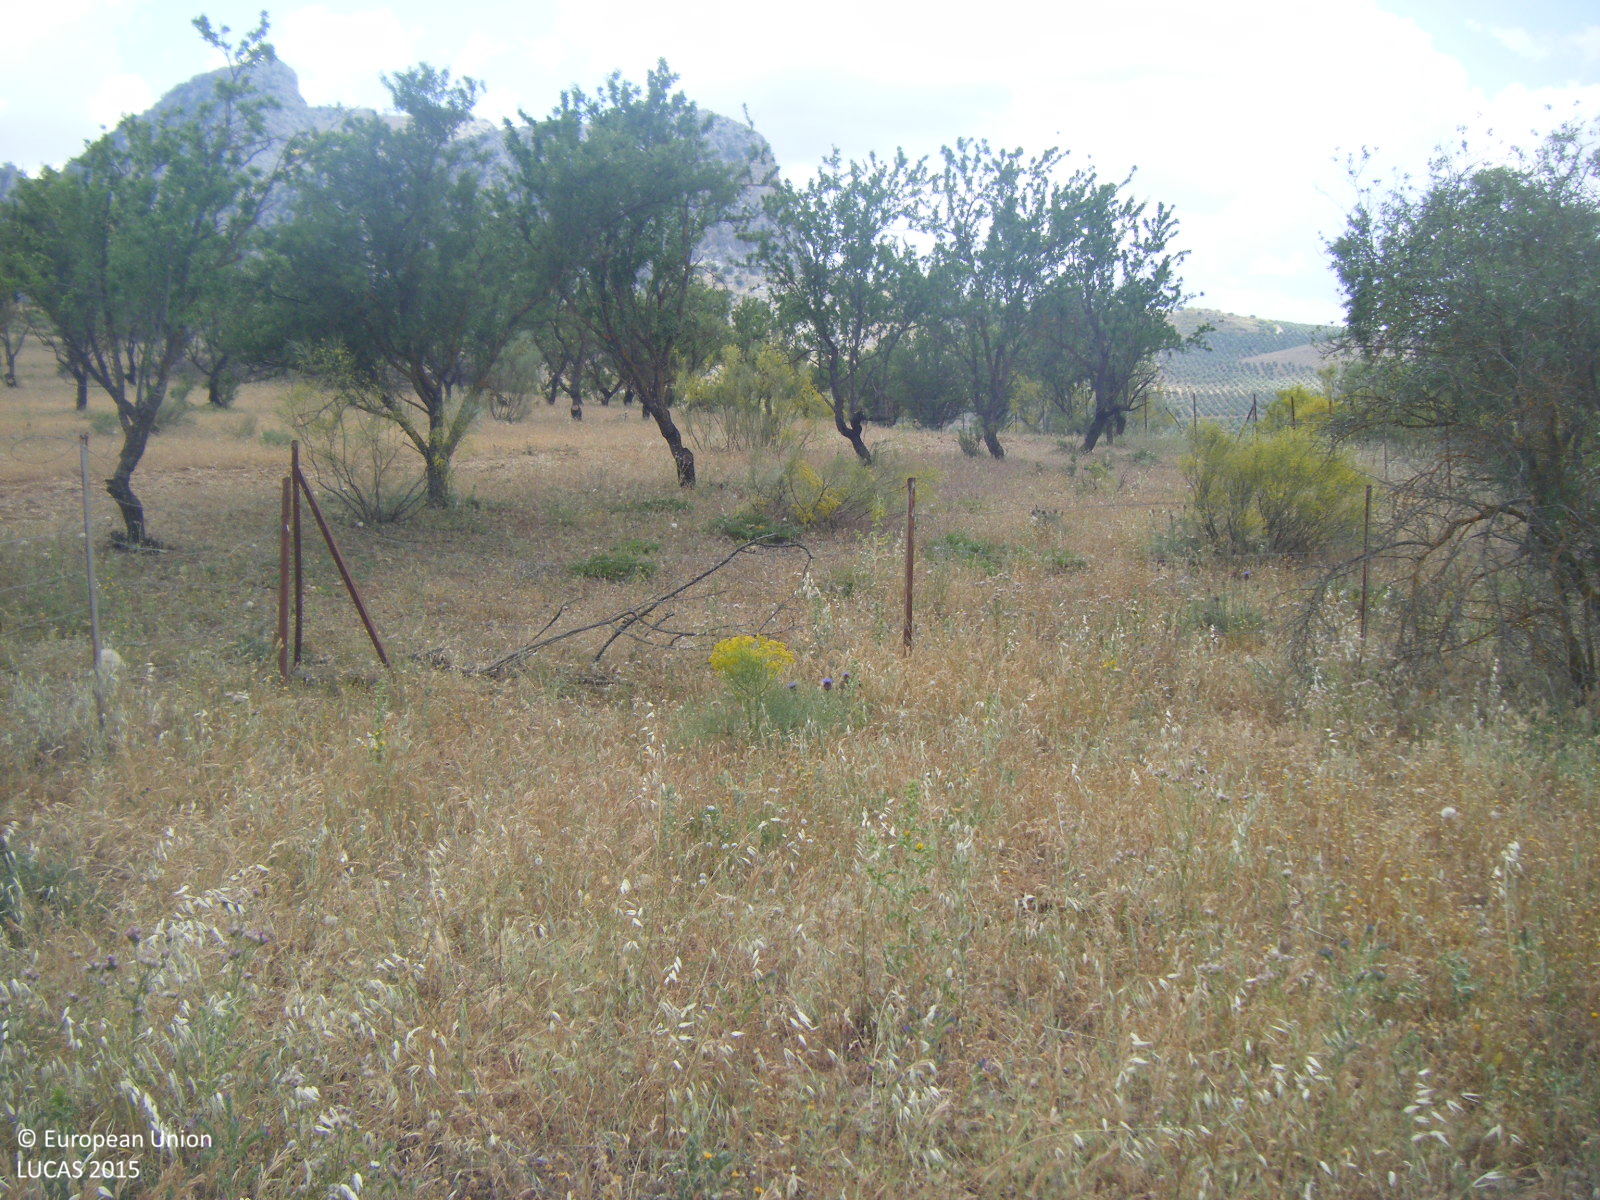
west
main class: Cropland
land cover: Nuts trees
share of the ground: 10 - 25 %
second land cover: Spontaneously vegetated surfaces
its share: > 75 %
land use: Agriculture (excluding fallow land and kitchen gardens)
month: May
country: ES
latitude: 37.0754
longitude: -4.4730
